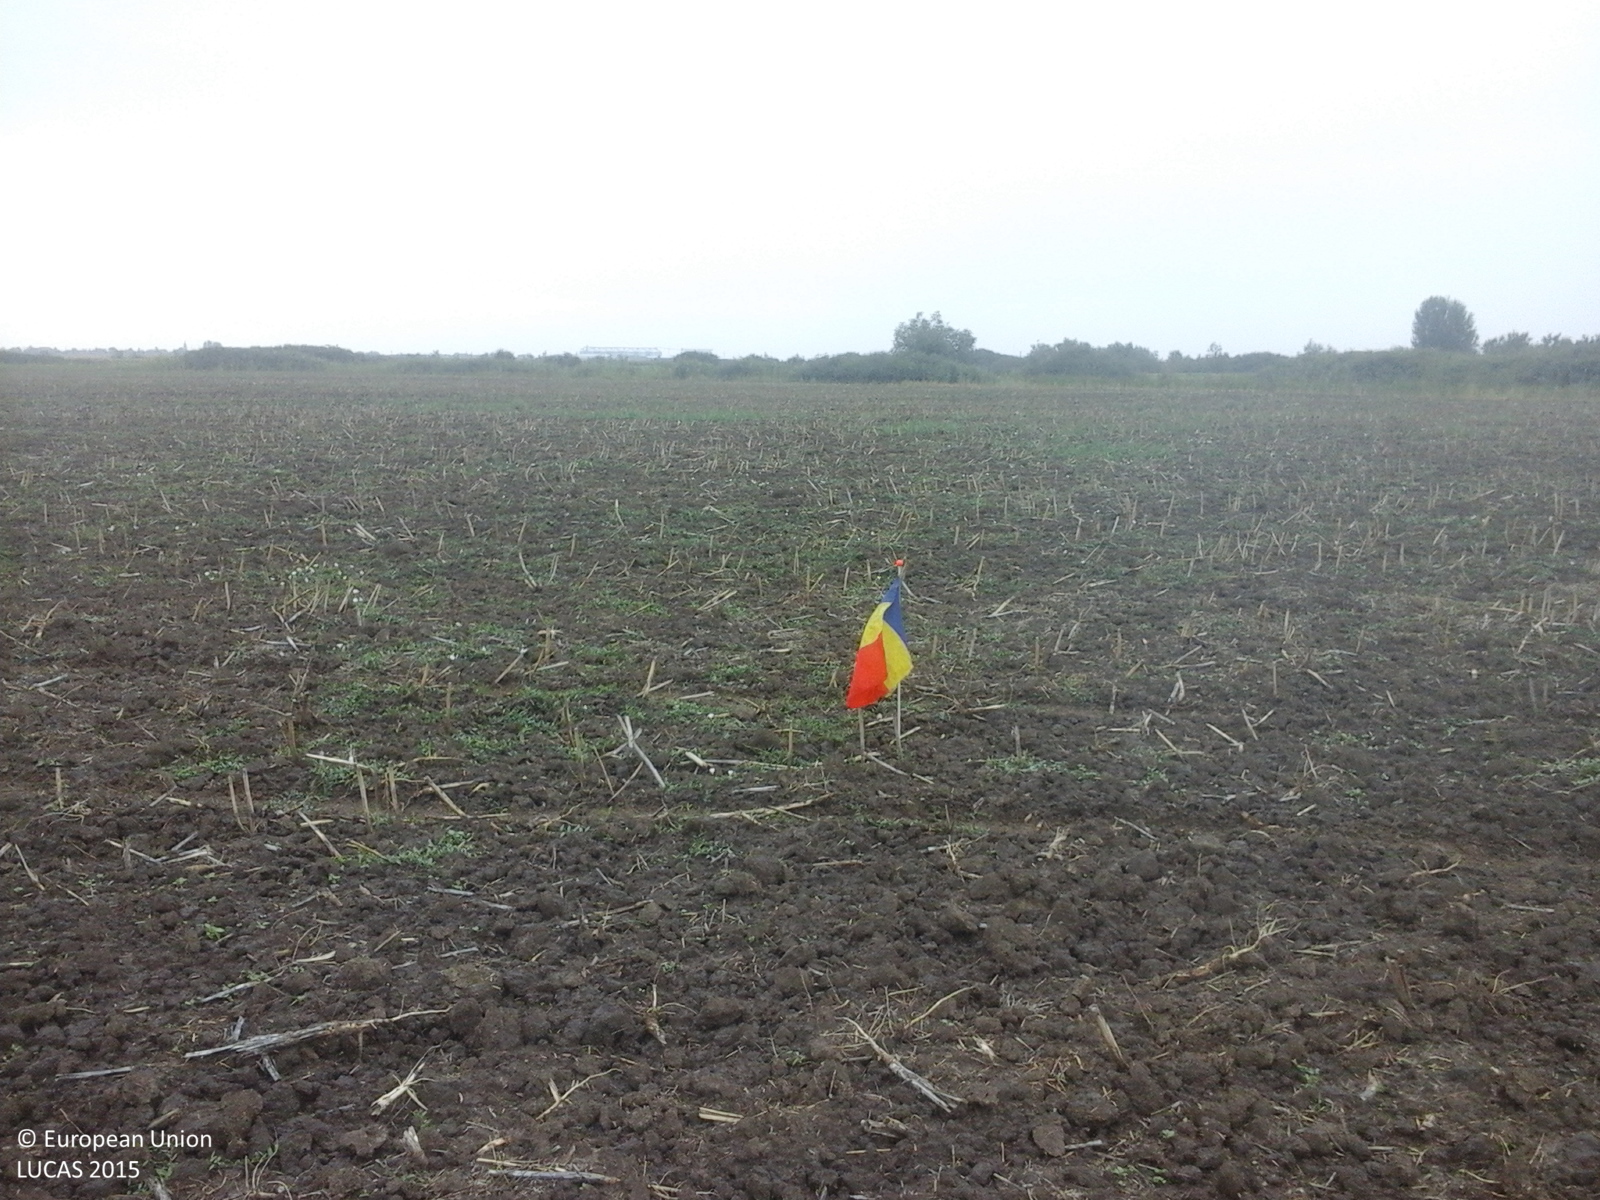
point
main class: Cropland
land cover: Rape and turnip rape
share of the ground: < 10 %
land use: Agriculture (excluding fallow land and kitchen gardens)
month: August
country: RO
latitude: 45.4209
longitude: 20.9782
